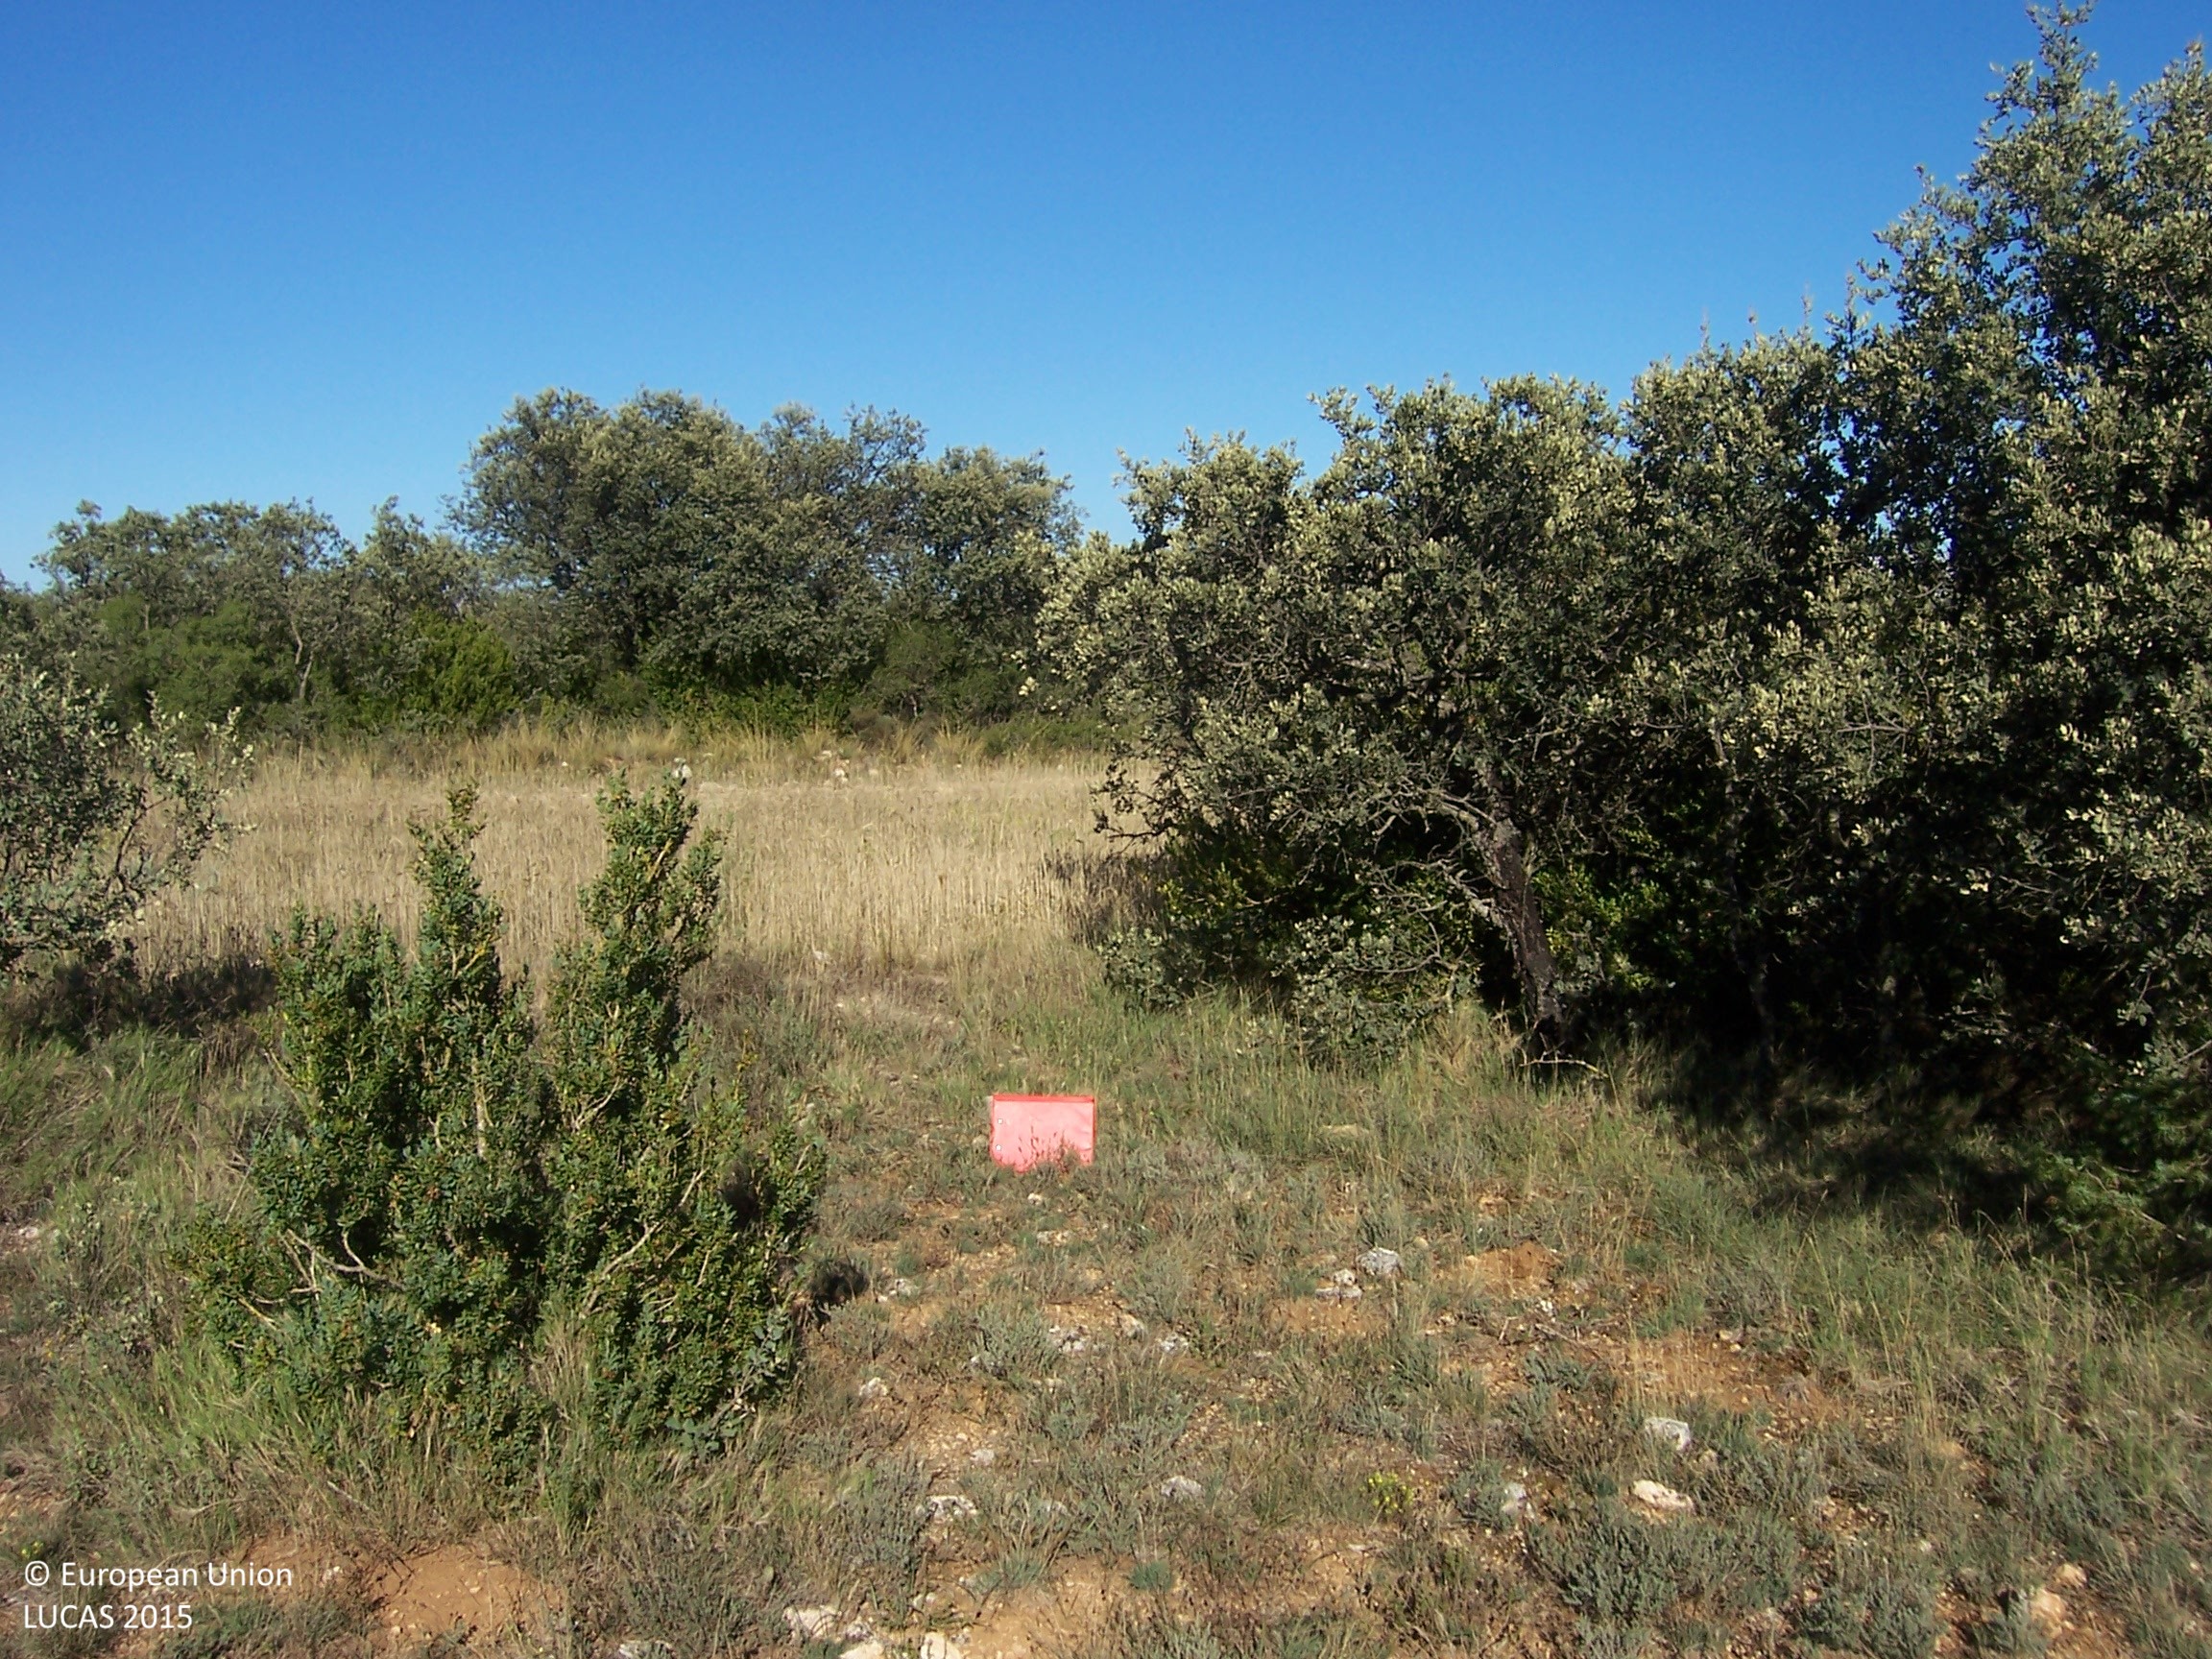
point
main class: Woodland
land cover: Broadleaved woodland
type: broadleaved evergreen forest
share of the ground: > 75 %
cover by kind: herbaceous plants 40 %, unconsolidated bare surface 30 %, broadleaved forest trees 20 %, shrubs 10 %
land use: Semi-natural and natural areas not in use
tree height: < 5 m
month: August
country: ES
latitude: 42.0072
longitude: 0.5058
